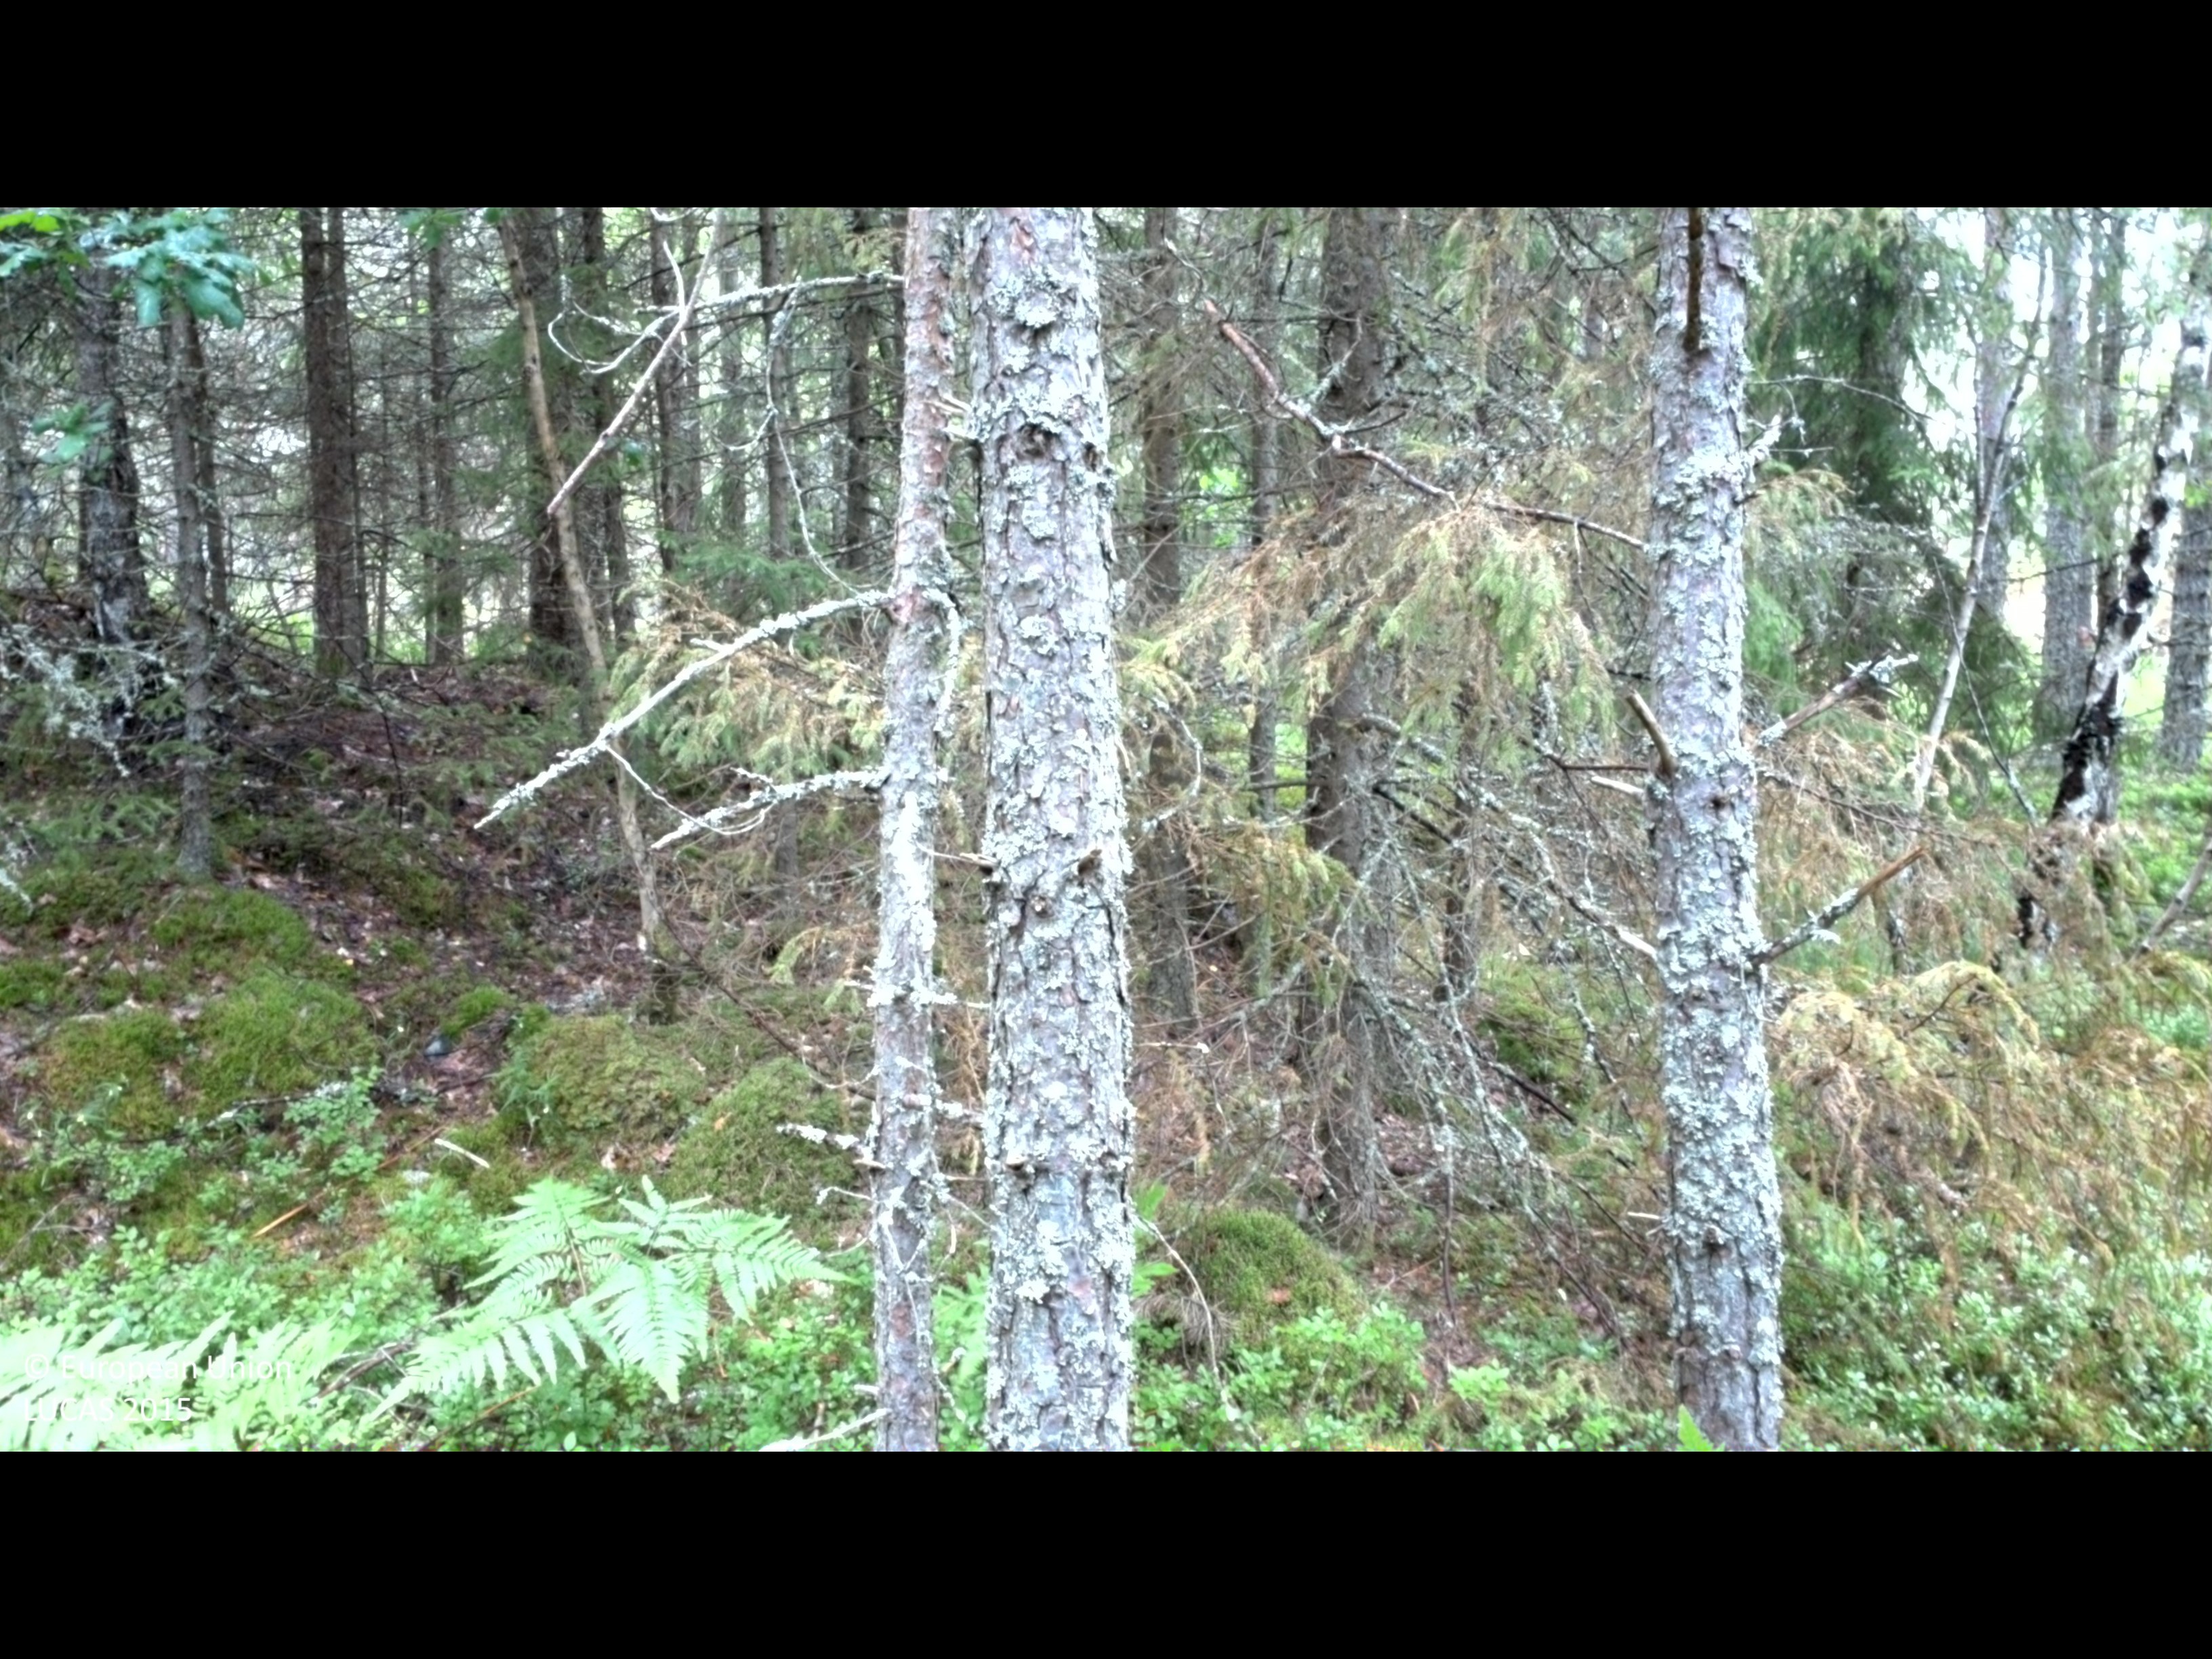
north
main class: Woodland
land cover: Pine dominated coniferous woodland
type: boreal forest
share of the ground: > 75 %
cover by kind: coniferous forest trees 65 %, broadleaved forest trees 15 %, shrubs 15 %, lichens and mosses 5 %
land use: Forestry
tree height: > 5 m
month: July
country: SE
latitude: 58.4028
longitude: 16.5504
